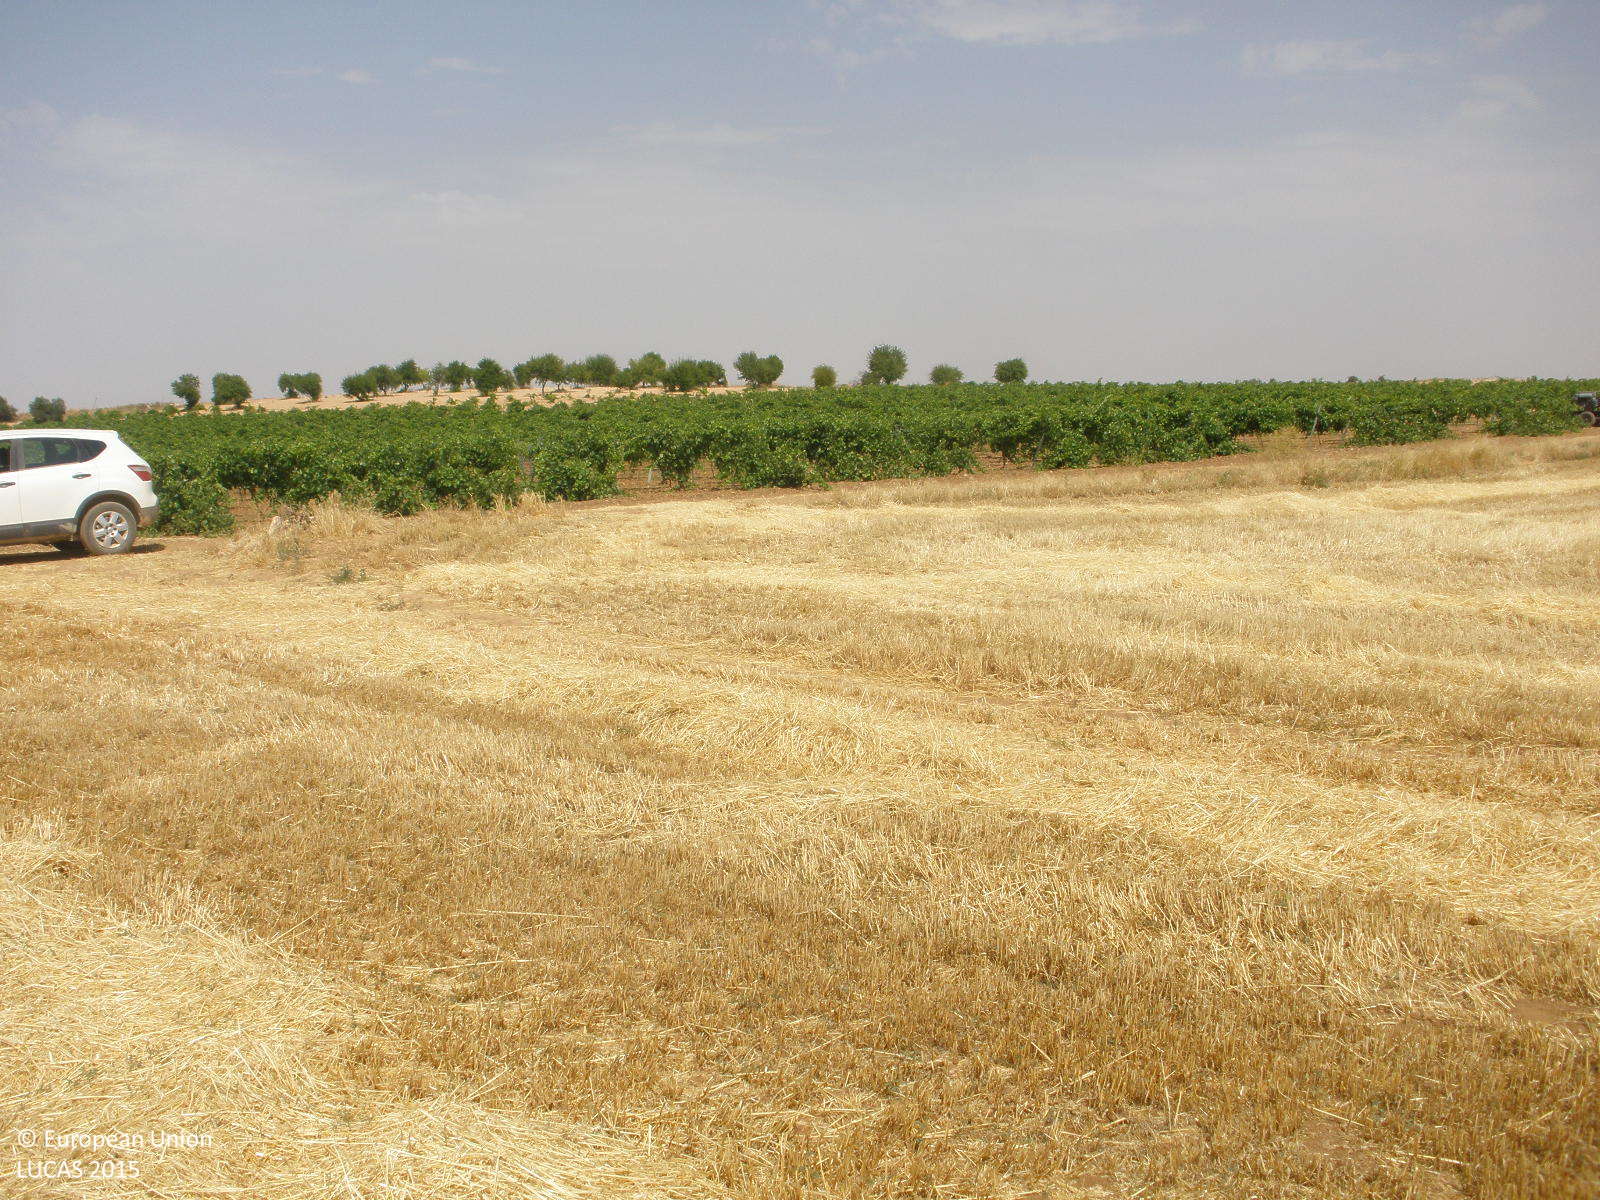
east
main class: Cropland
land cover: Barley
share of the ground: < 10 %
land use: Agriculture (excluding fallow land and kitchen gardens)
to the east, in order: Barley; Grass margins; Barley; Grass margins; Tracks; Vineyards; Grass margins; Vineyards; Nuts trees; Grassland without tree/shrub cover; Tracks; Grass margins; Barley
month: July
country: ES
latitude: 39.9083
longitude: -3.4211
